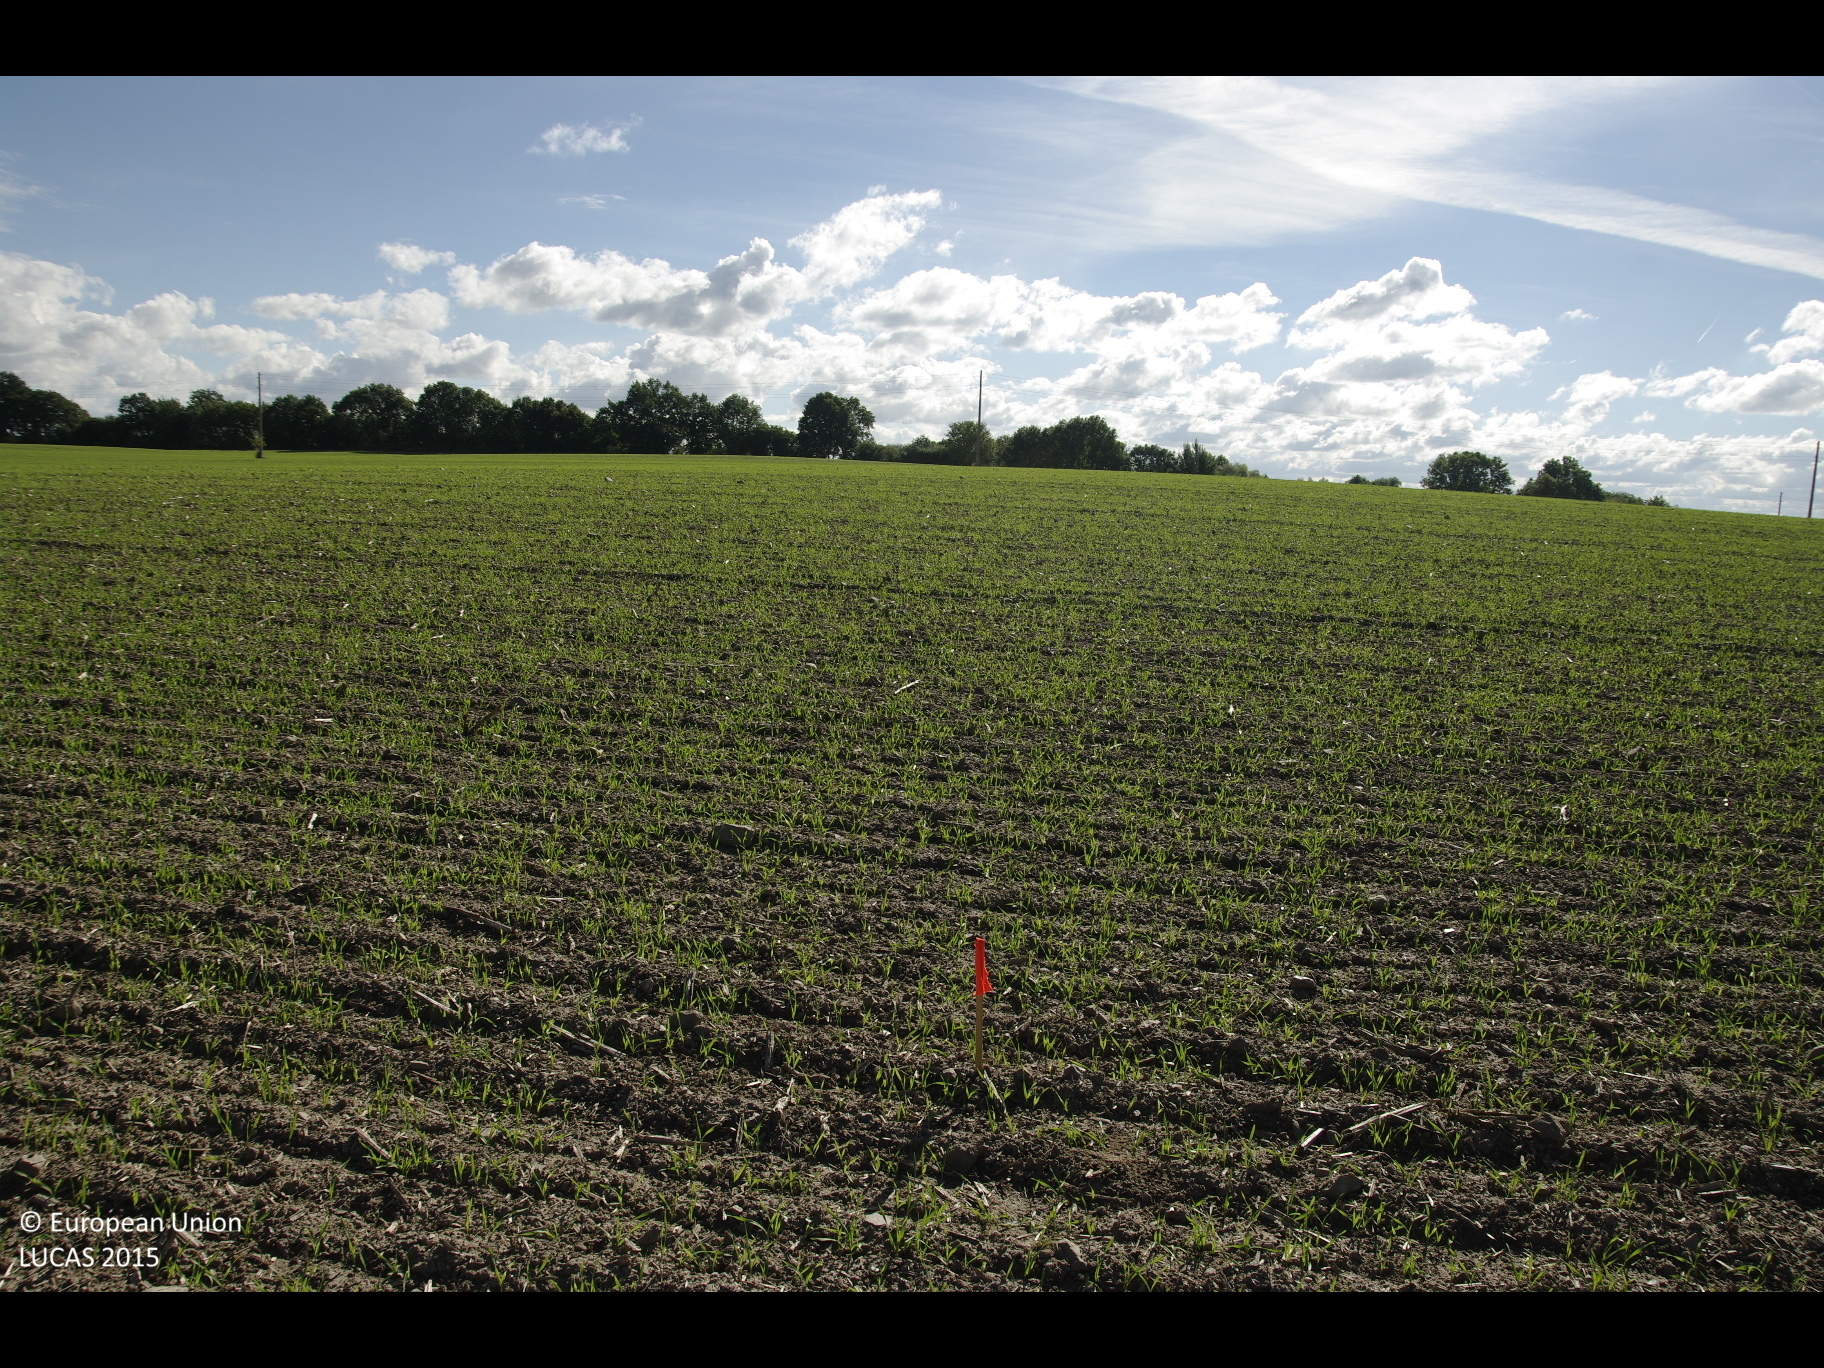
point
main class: Cropland
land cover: Rape and turnip rape
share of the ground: < 10 %
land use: Agriculture (excluding fallow land and kitchen gardens)
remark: Harvested field
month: September
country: DE
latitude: 53.9178
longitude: 11.1413
